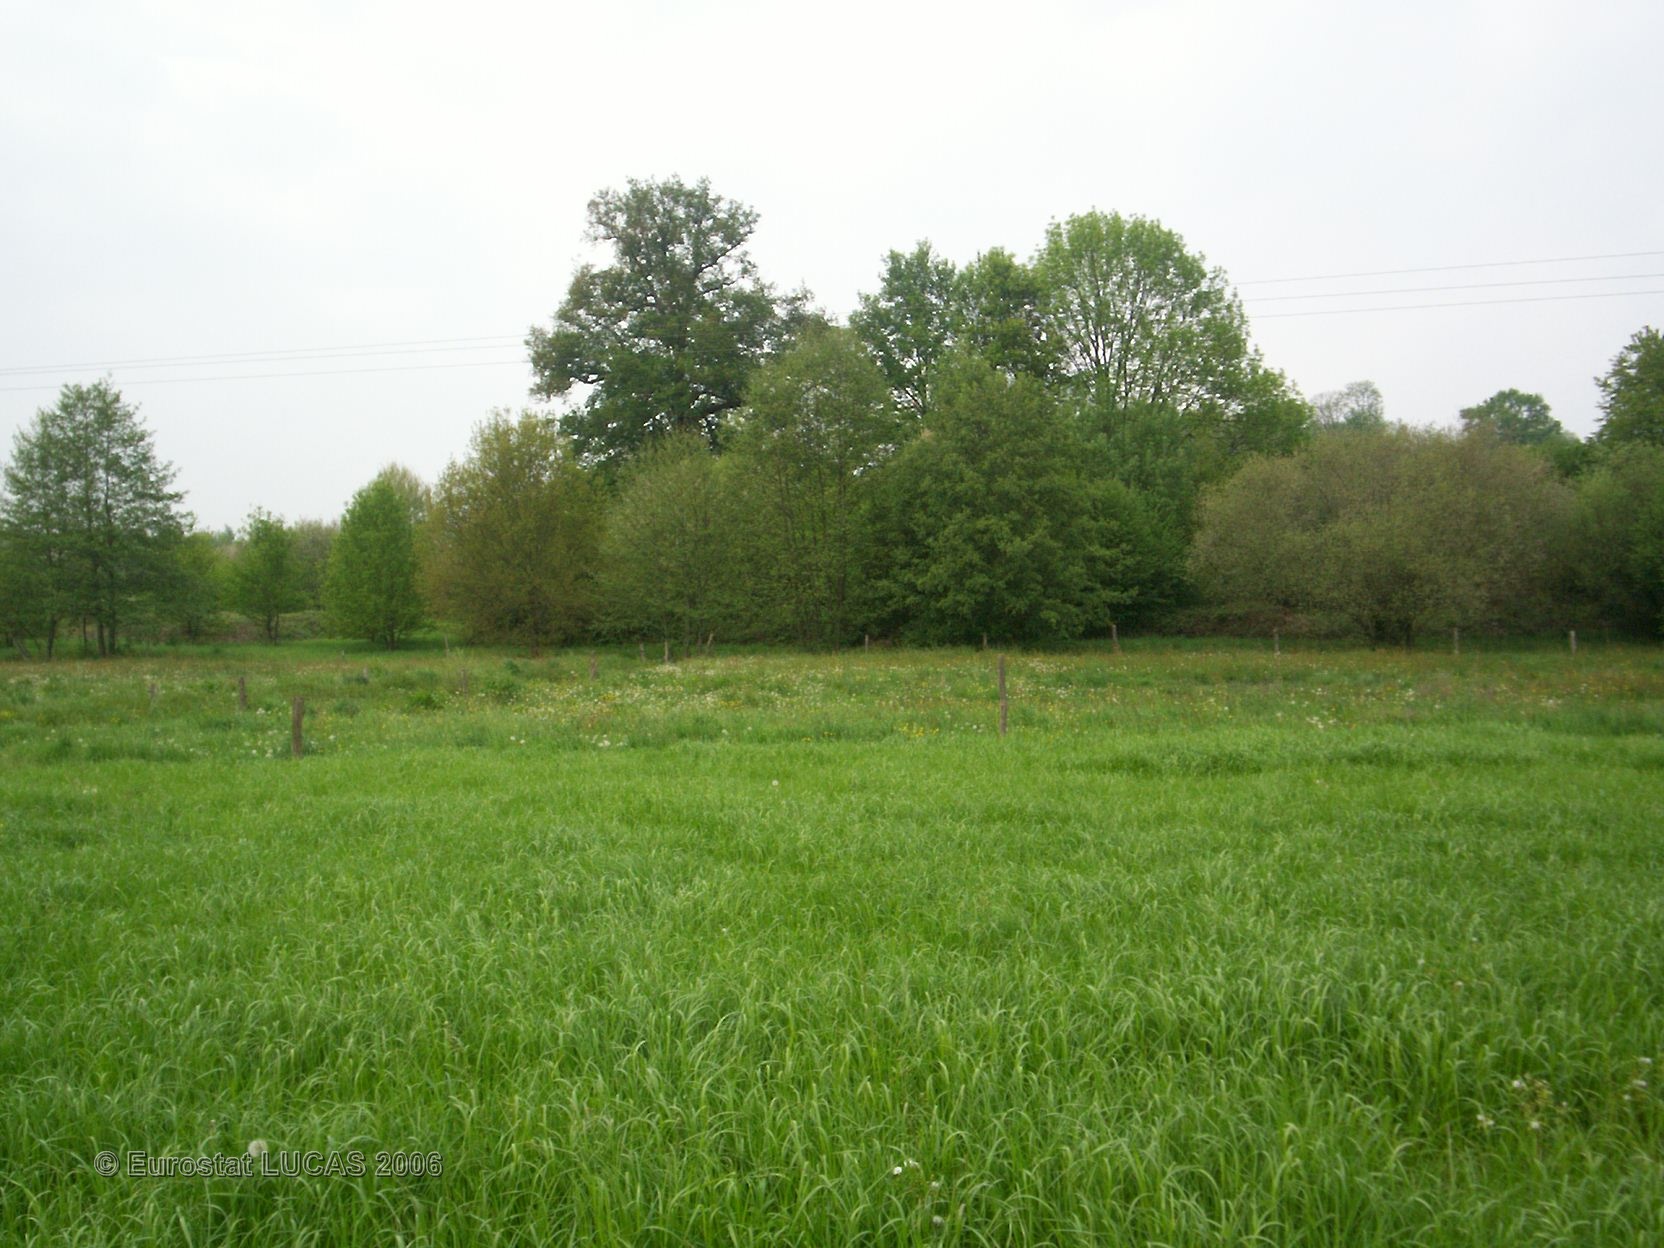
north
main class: Grassland
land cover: Grassland without tree/shrub cover
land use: Agriculture (excluding fallow land and kitchen gardens)
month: May
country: FR
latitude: 47.8682
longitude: 0.3099
